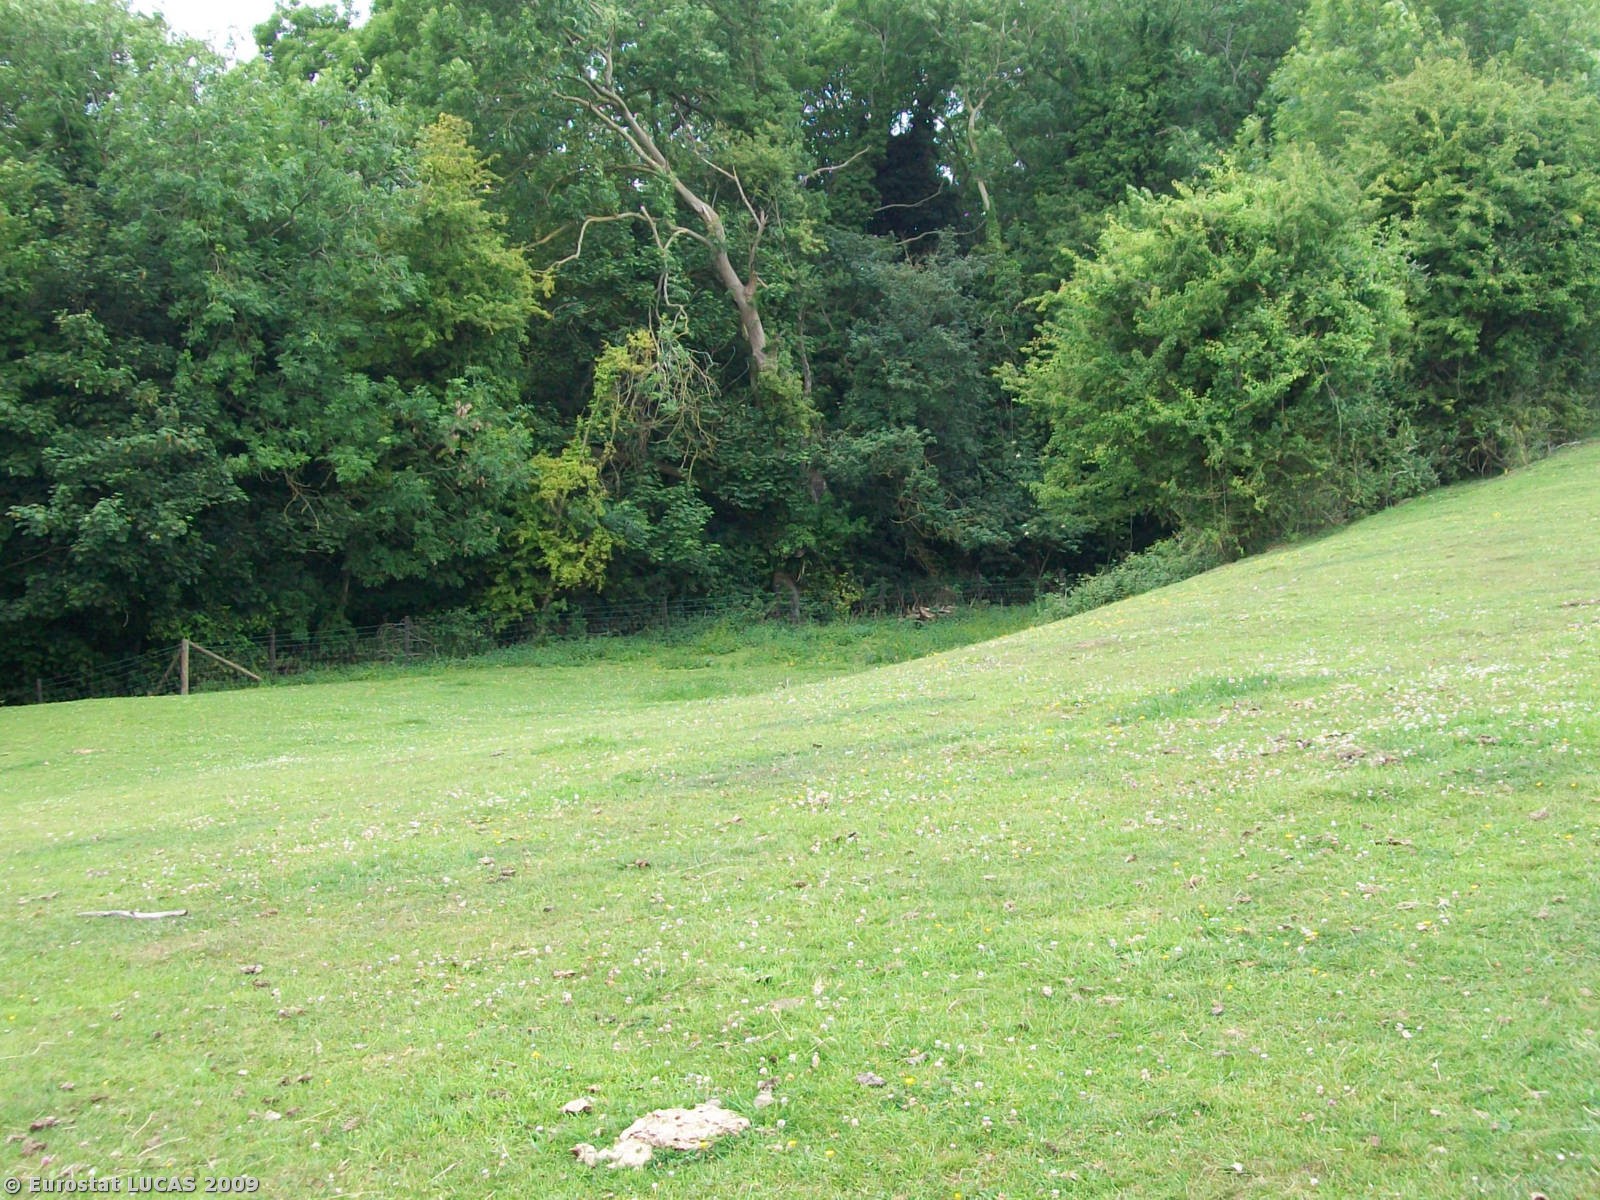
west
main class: Grassland
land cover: Grassland without tree/shrub cover
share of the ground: > 75 %
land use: Agriculture (excluding fallow land and kitchen gardens)
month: June
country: GB
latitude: 51.3192
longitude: -2.2734
